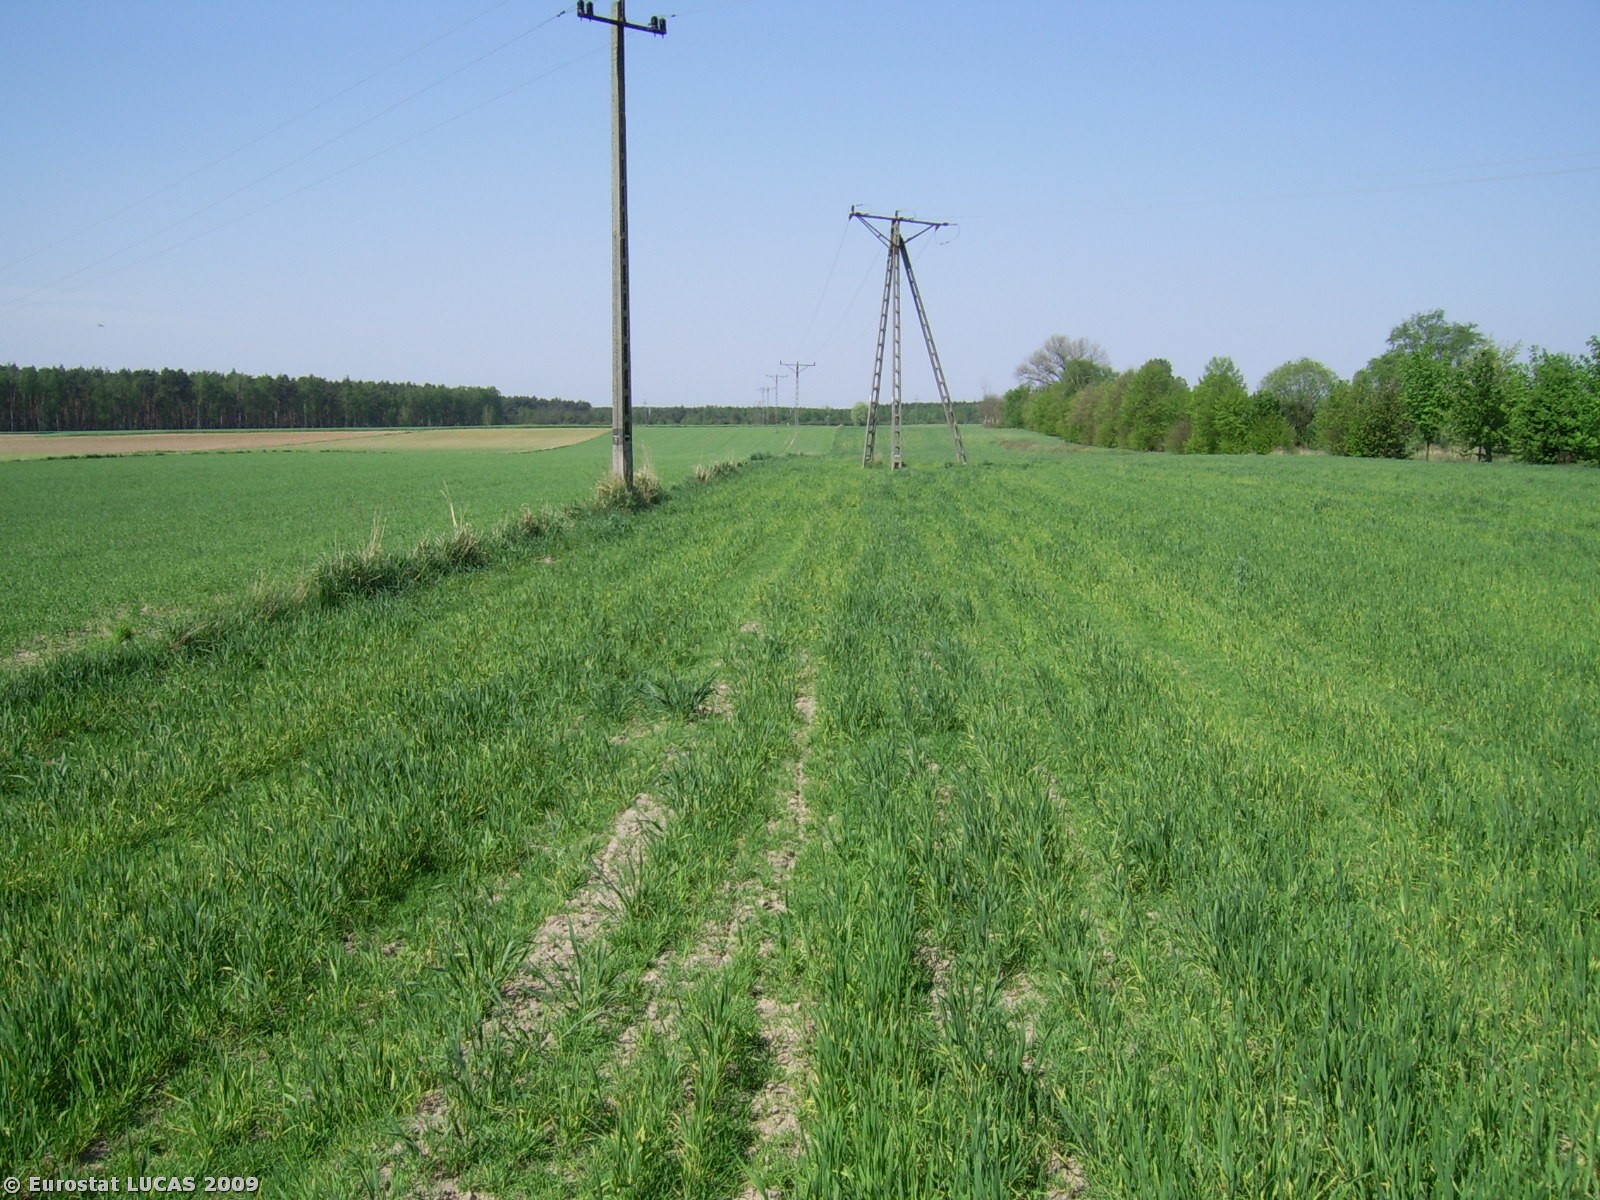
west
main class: Cropland
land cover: Common wheat
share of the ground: > 75 %
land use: Agriculture (excluding fallow land and kitchen gardens)
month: April
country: PL
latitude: 52.2109
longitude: 16.9318
